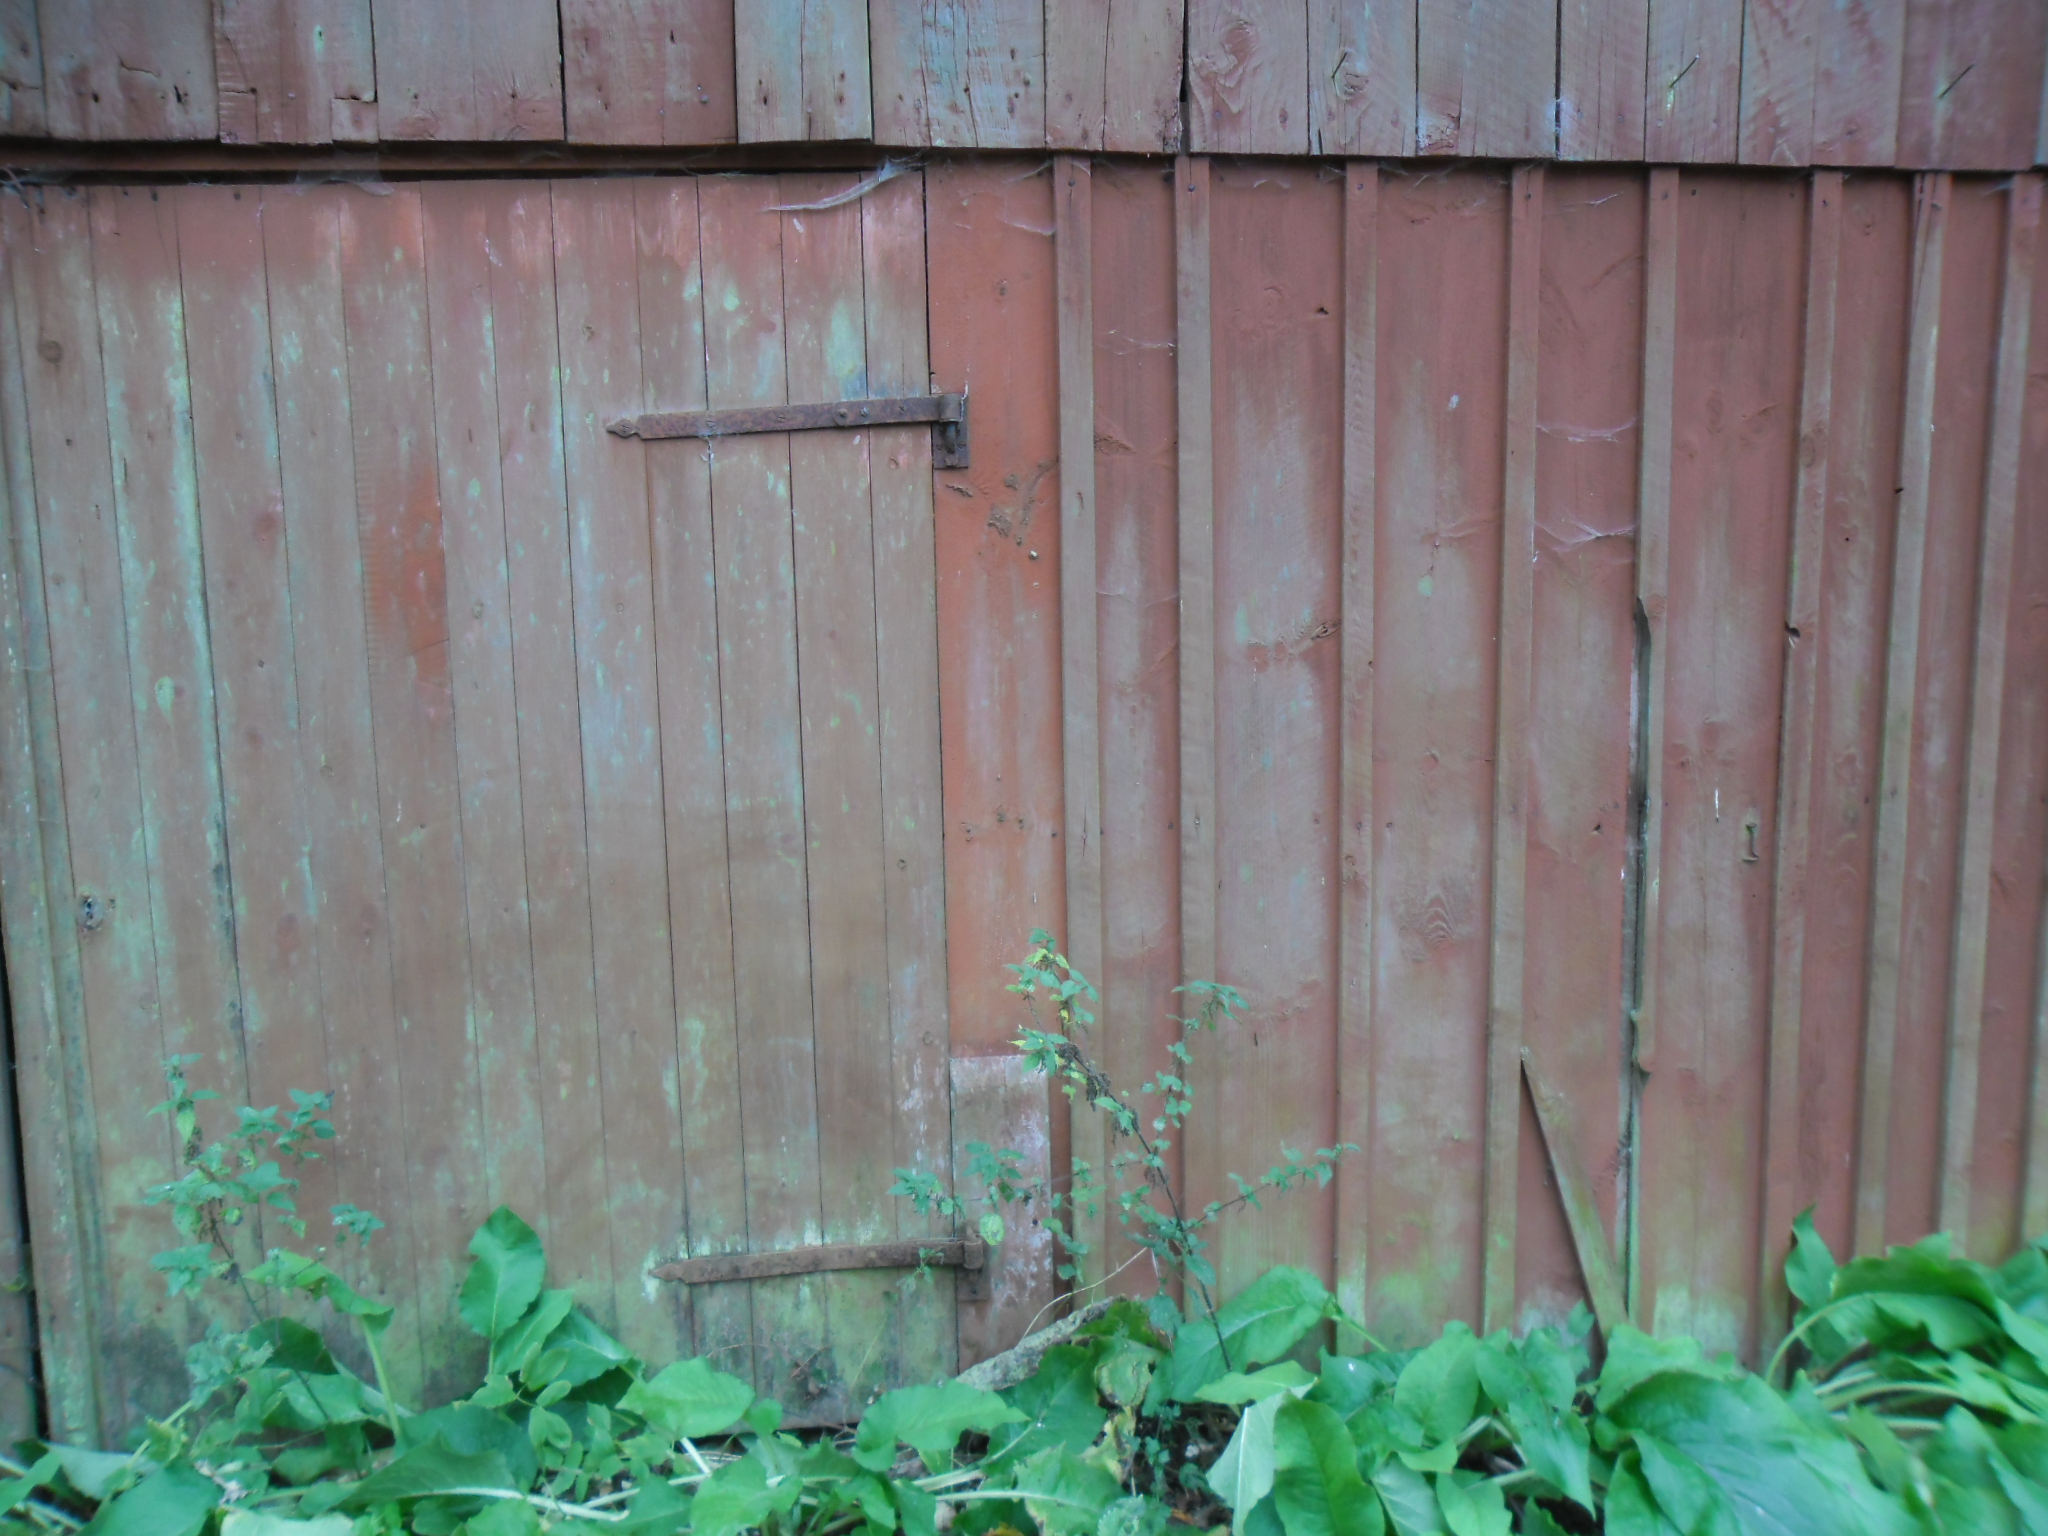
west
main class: Grassland
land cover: Grassland without tree/shrub cover
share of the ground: > 75 %
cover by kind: herbaceous plants 100 %
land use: Amenities, museums, leisure
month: October
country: SE
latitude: 56.0982
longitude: 13.7110
